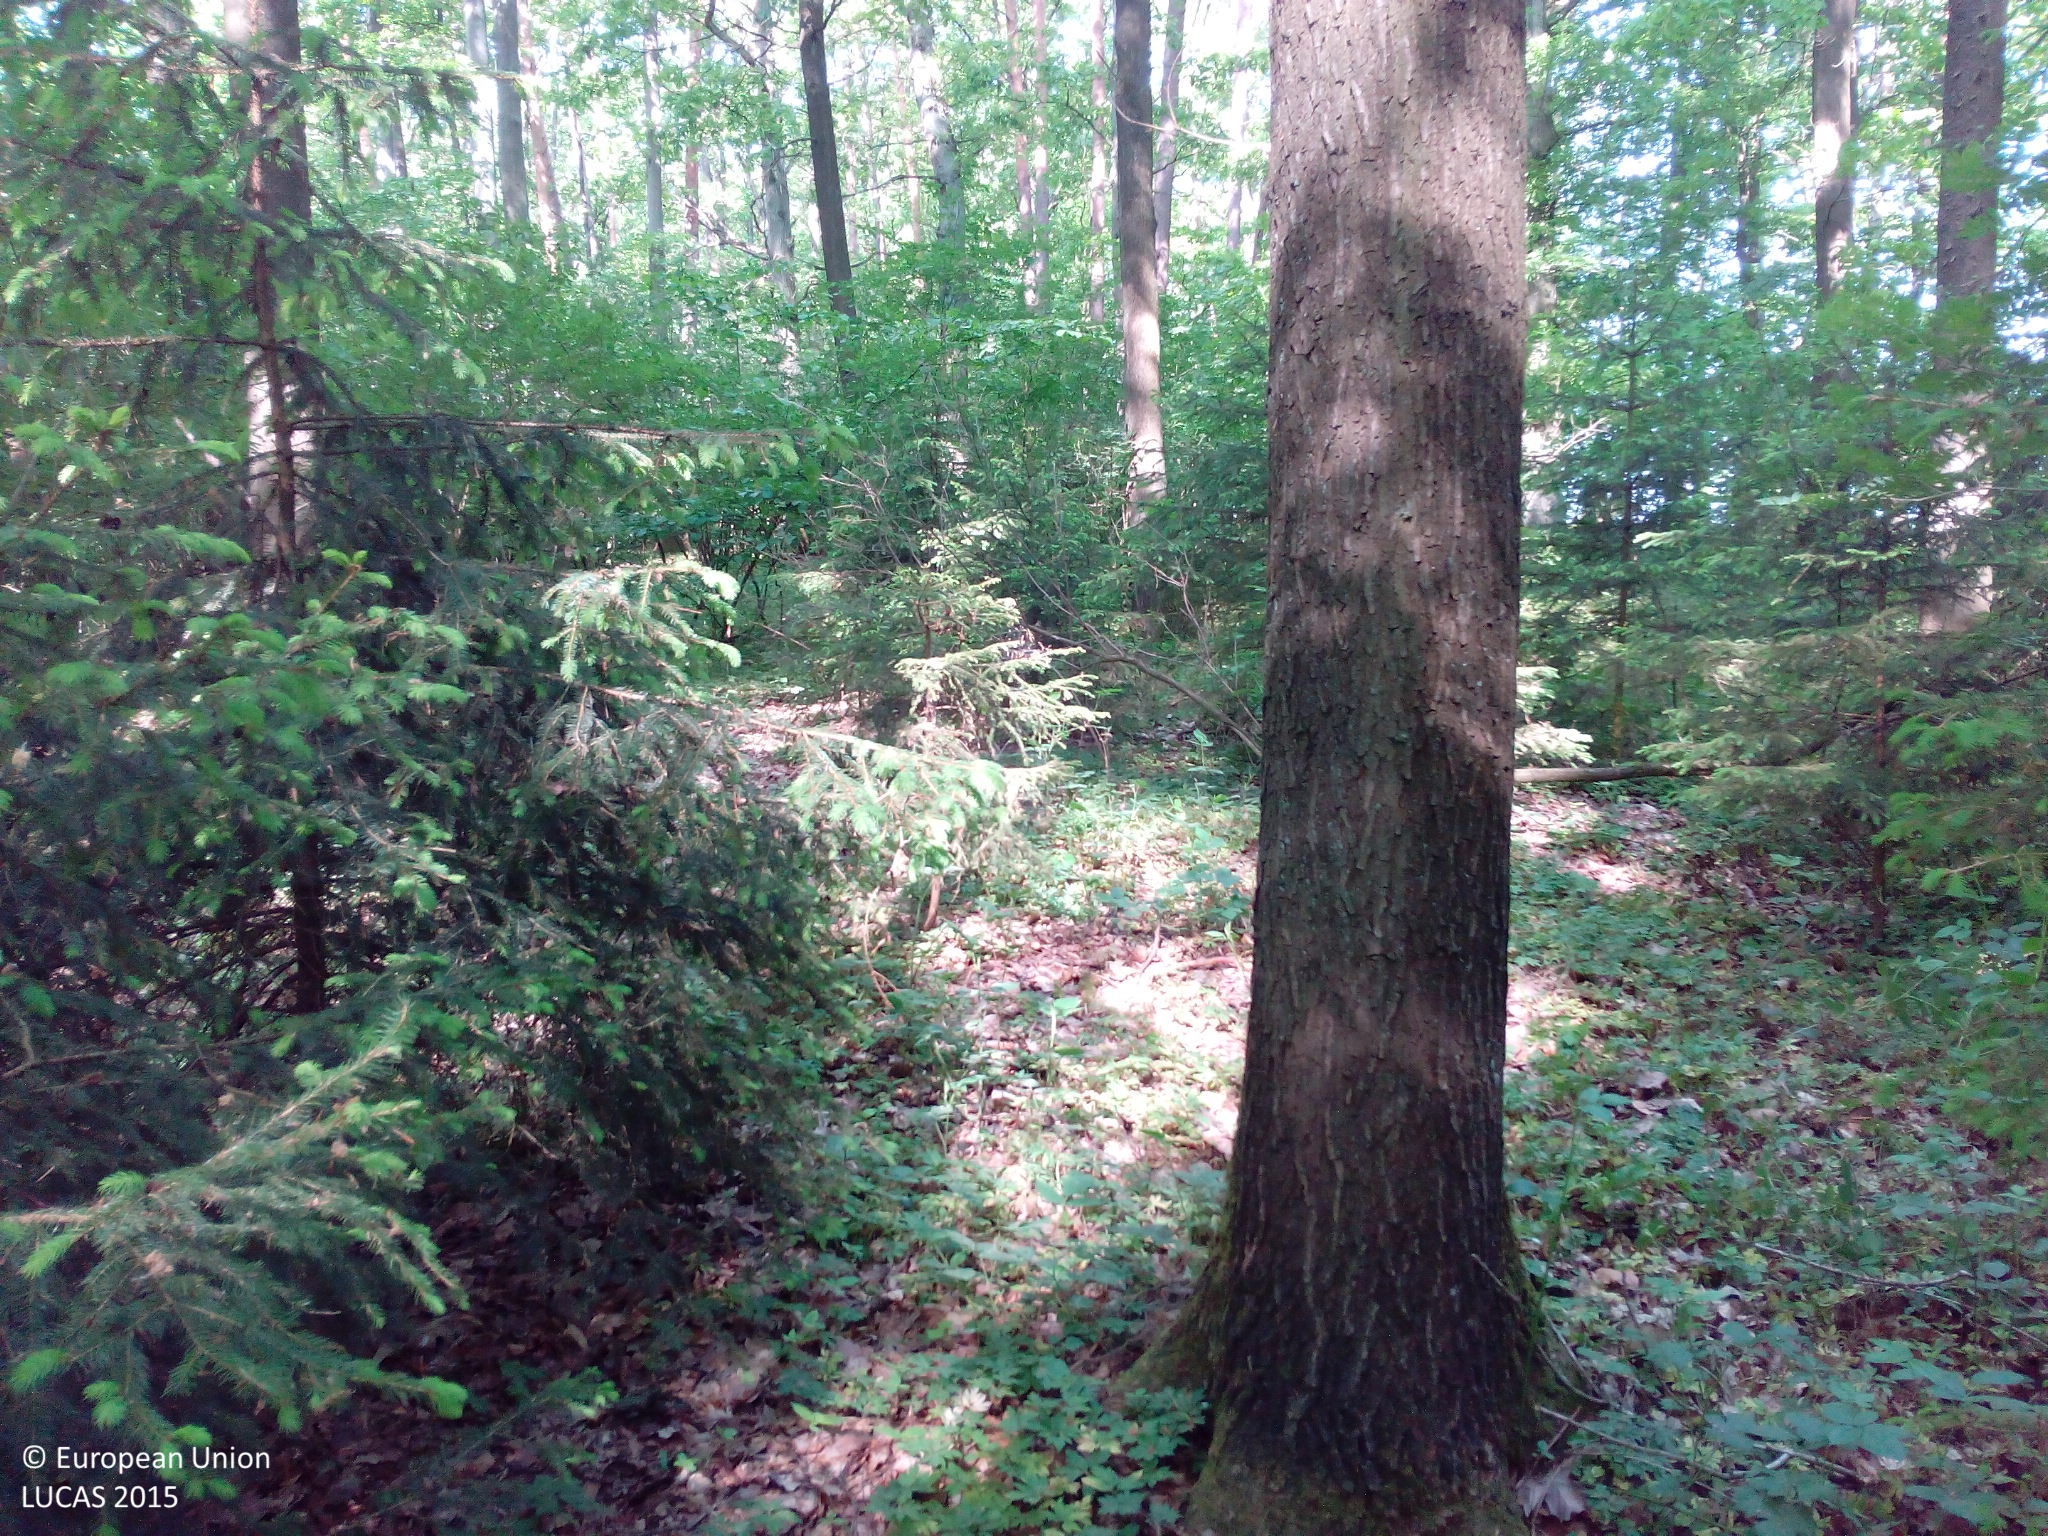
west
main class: Woodland
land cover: Broadleaved woodland
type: mesophytic deciduous forest
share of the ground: > 75 %
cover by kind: broadleaved forest trees 85 %, coniferous forest trees 10 %, herbaceous plants 5 %
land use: Forestry
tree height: > 5 m
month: May
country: DE
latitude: 50.0907
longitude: 10.9083
